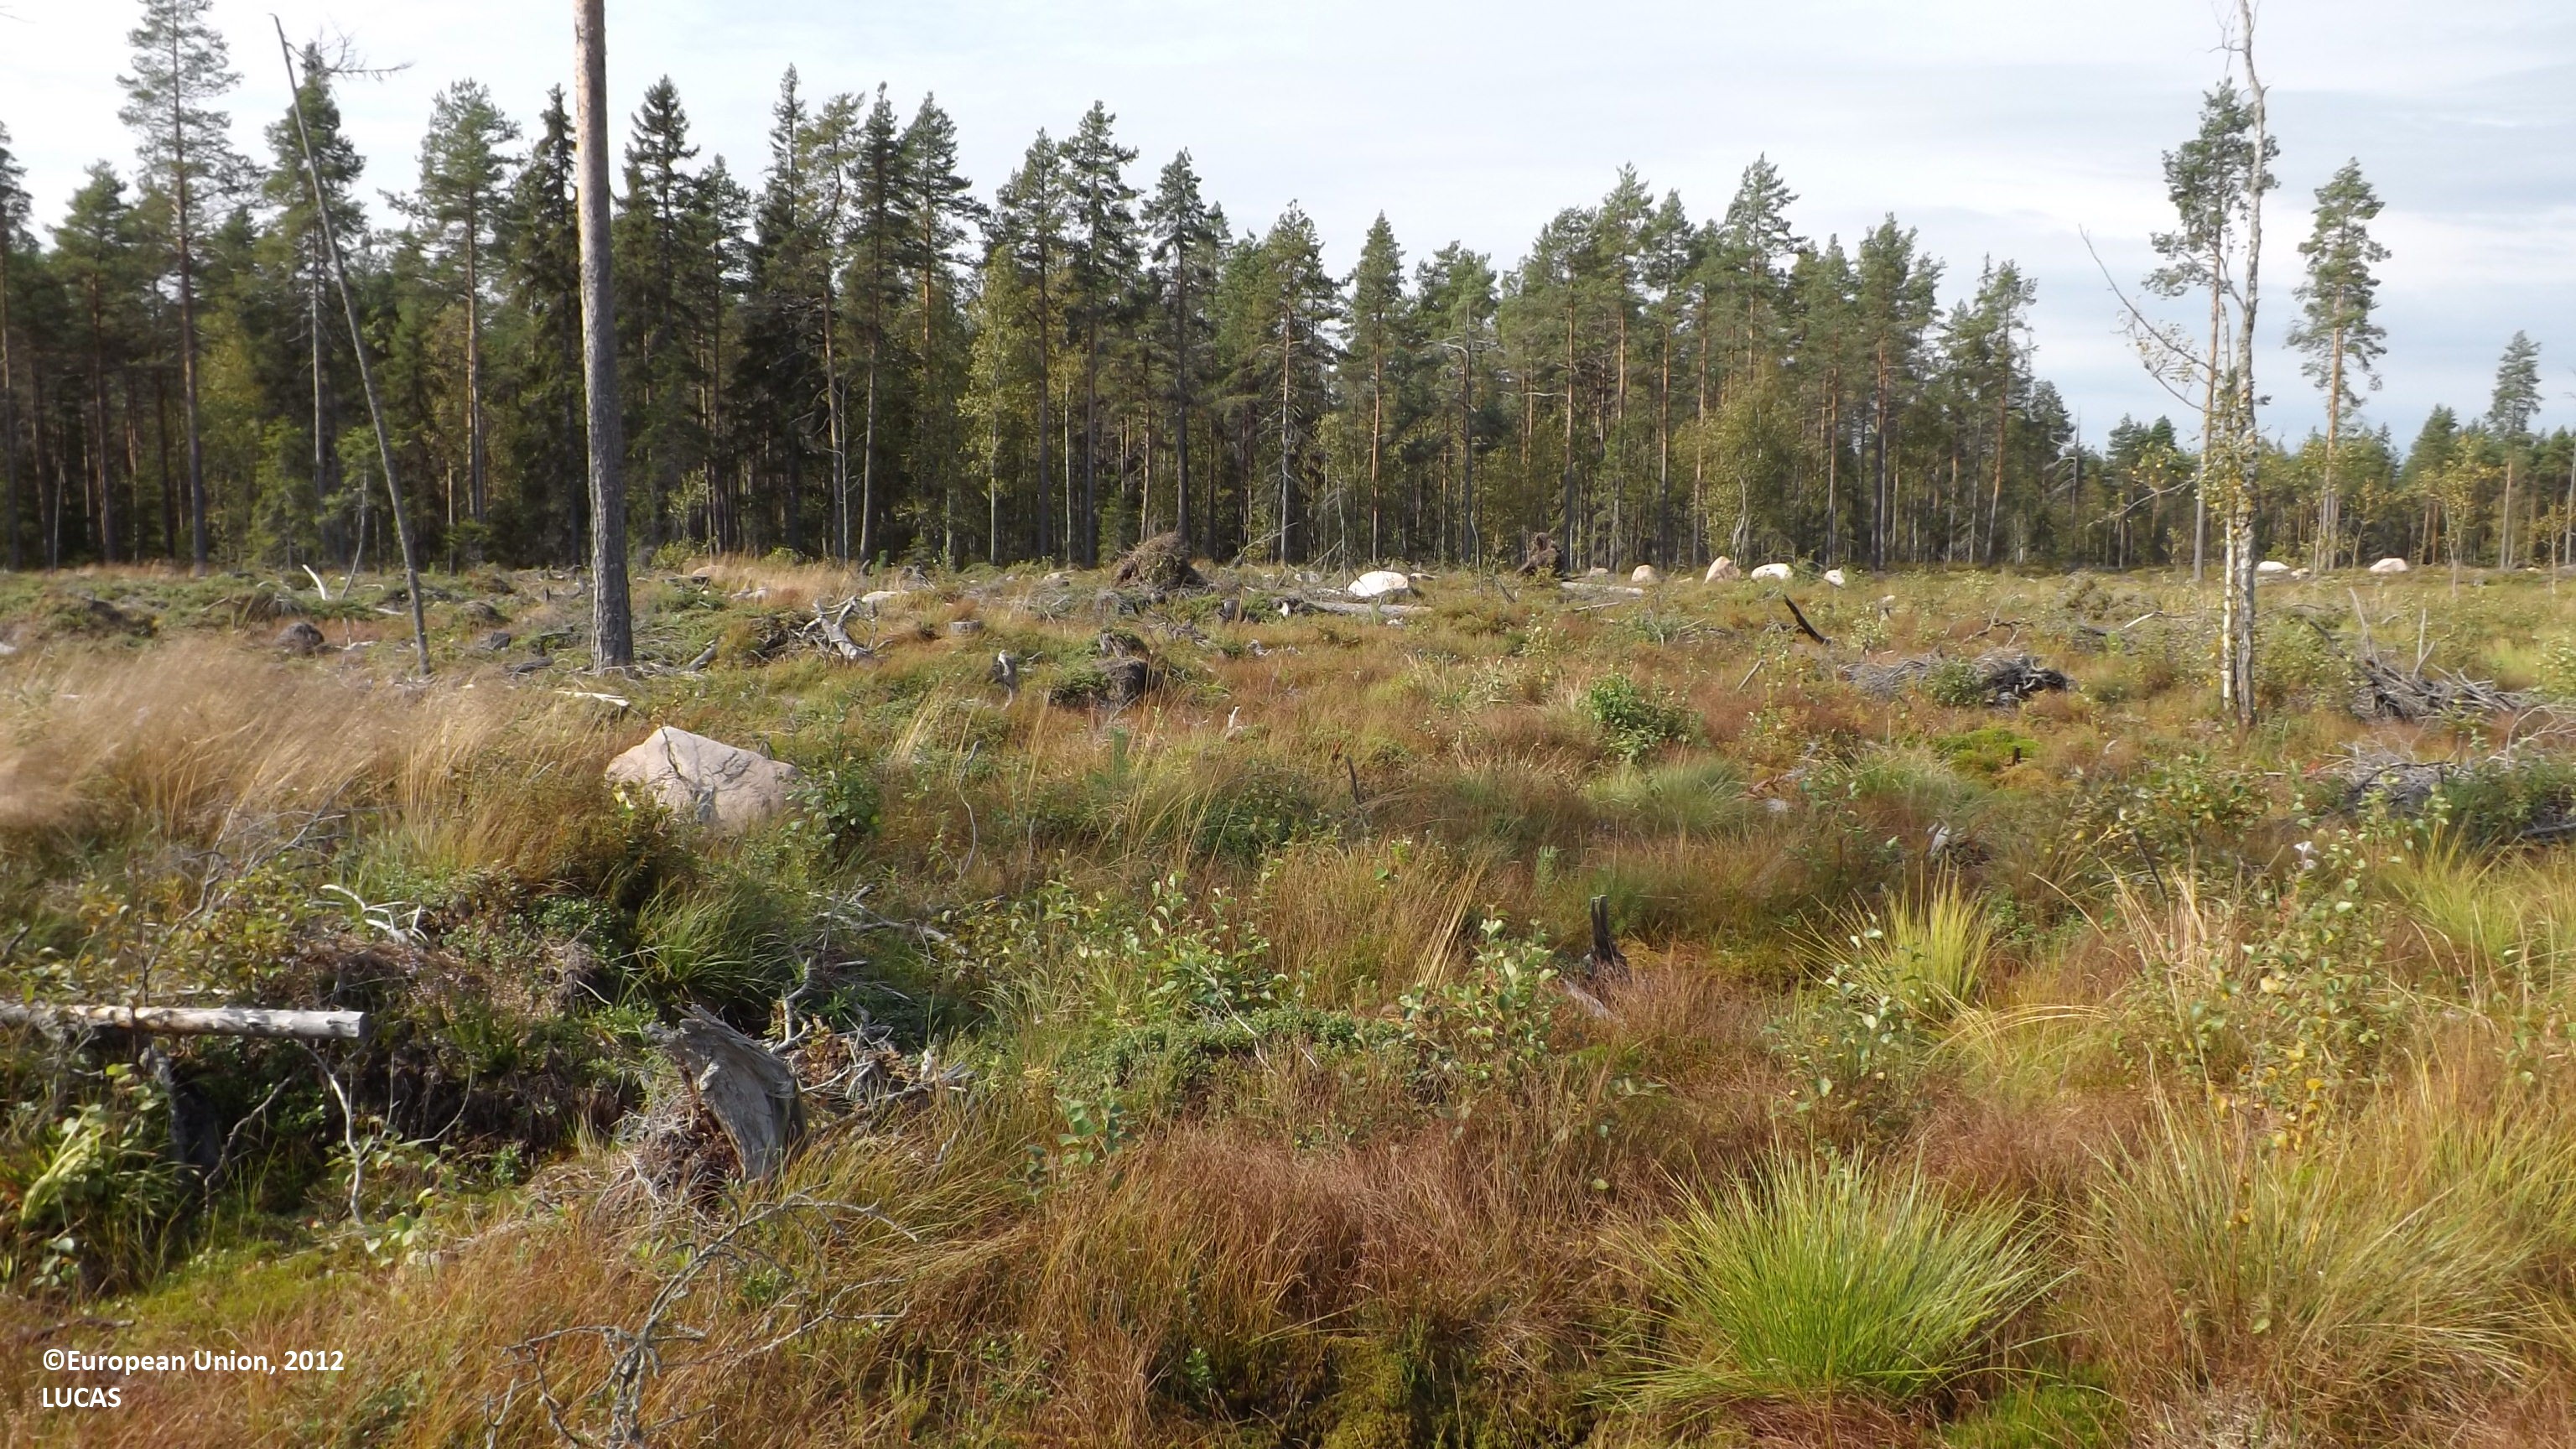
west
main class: Grassland
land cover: Grassland with sparse tree/shrub cover
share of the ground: 25 - 50 %
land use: Forestry
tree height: < 5 m
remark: Clear cut
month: August
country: FI
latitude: 63.7559
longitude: 23.5803
